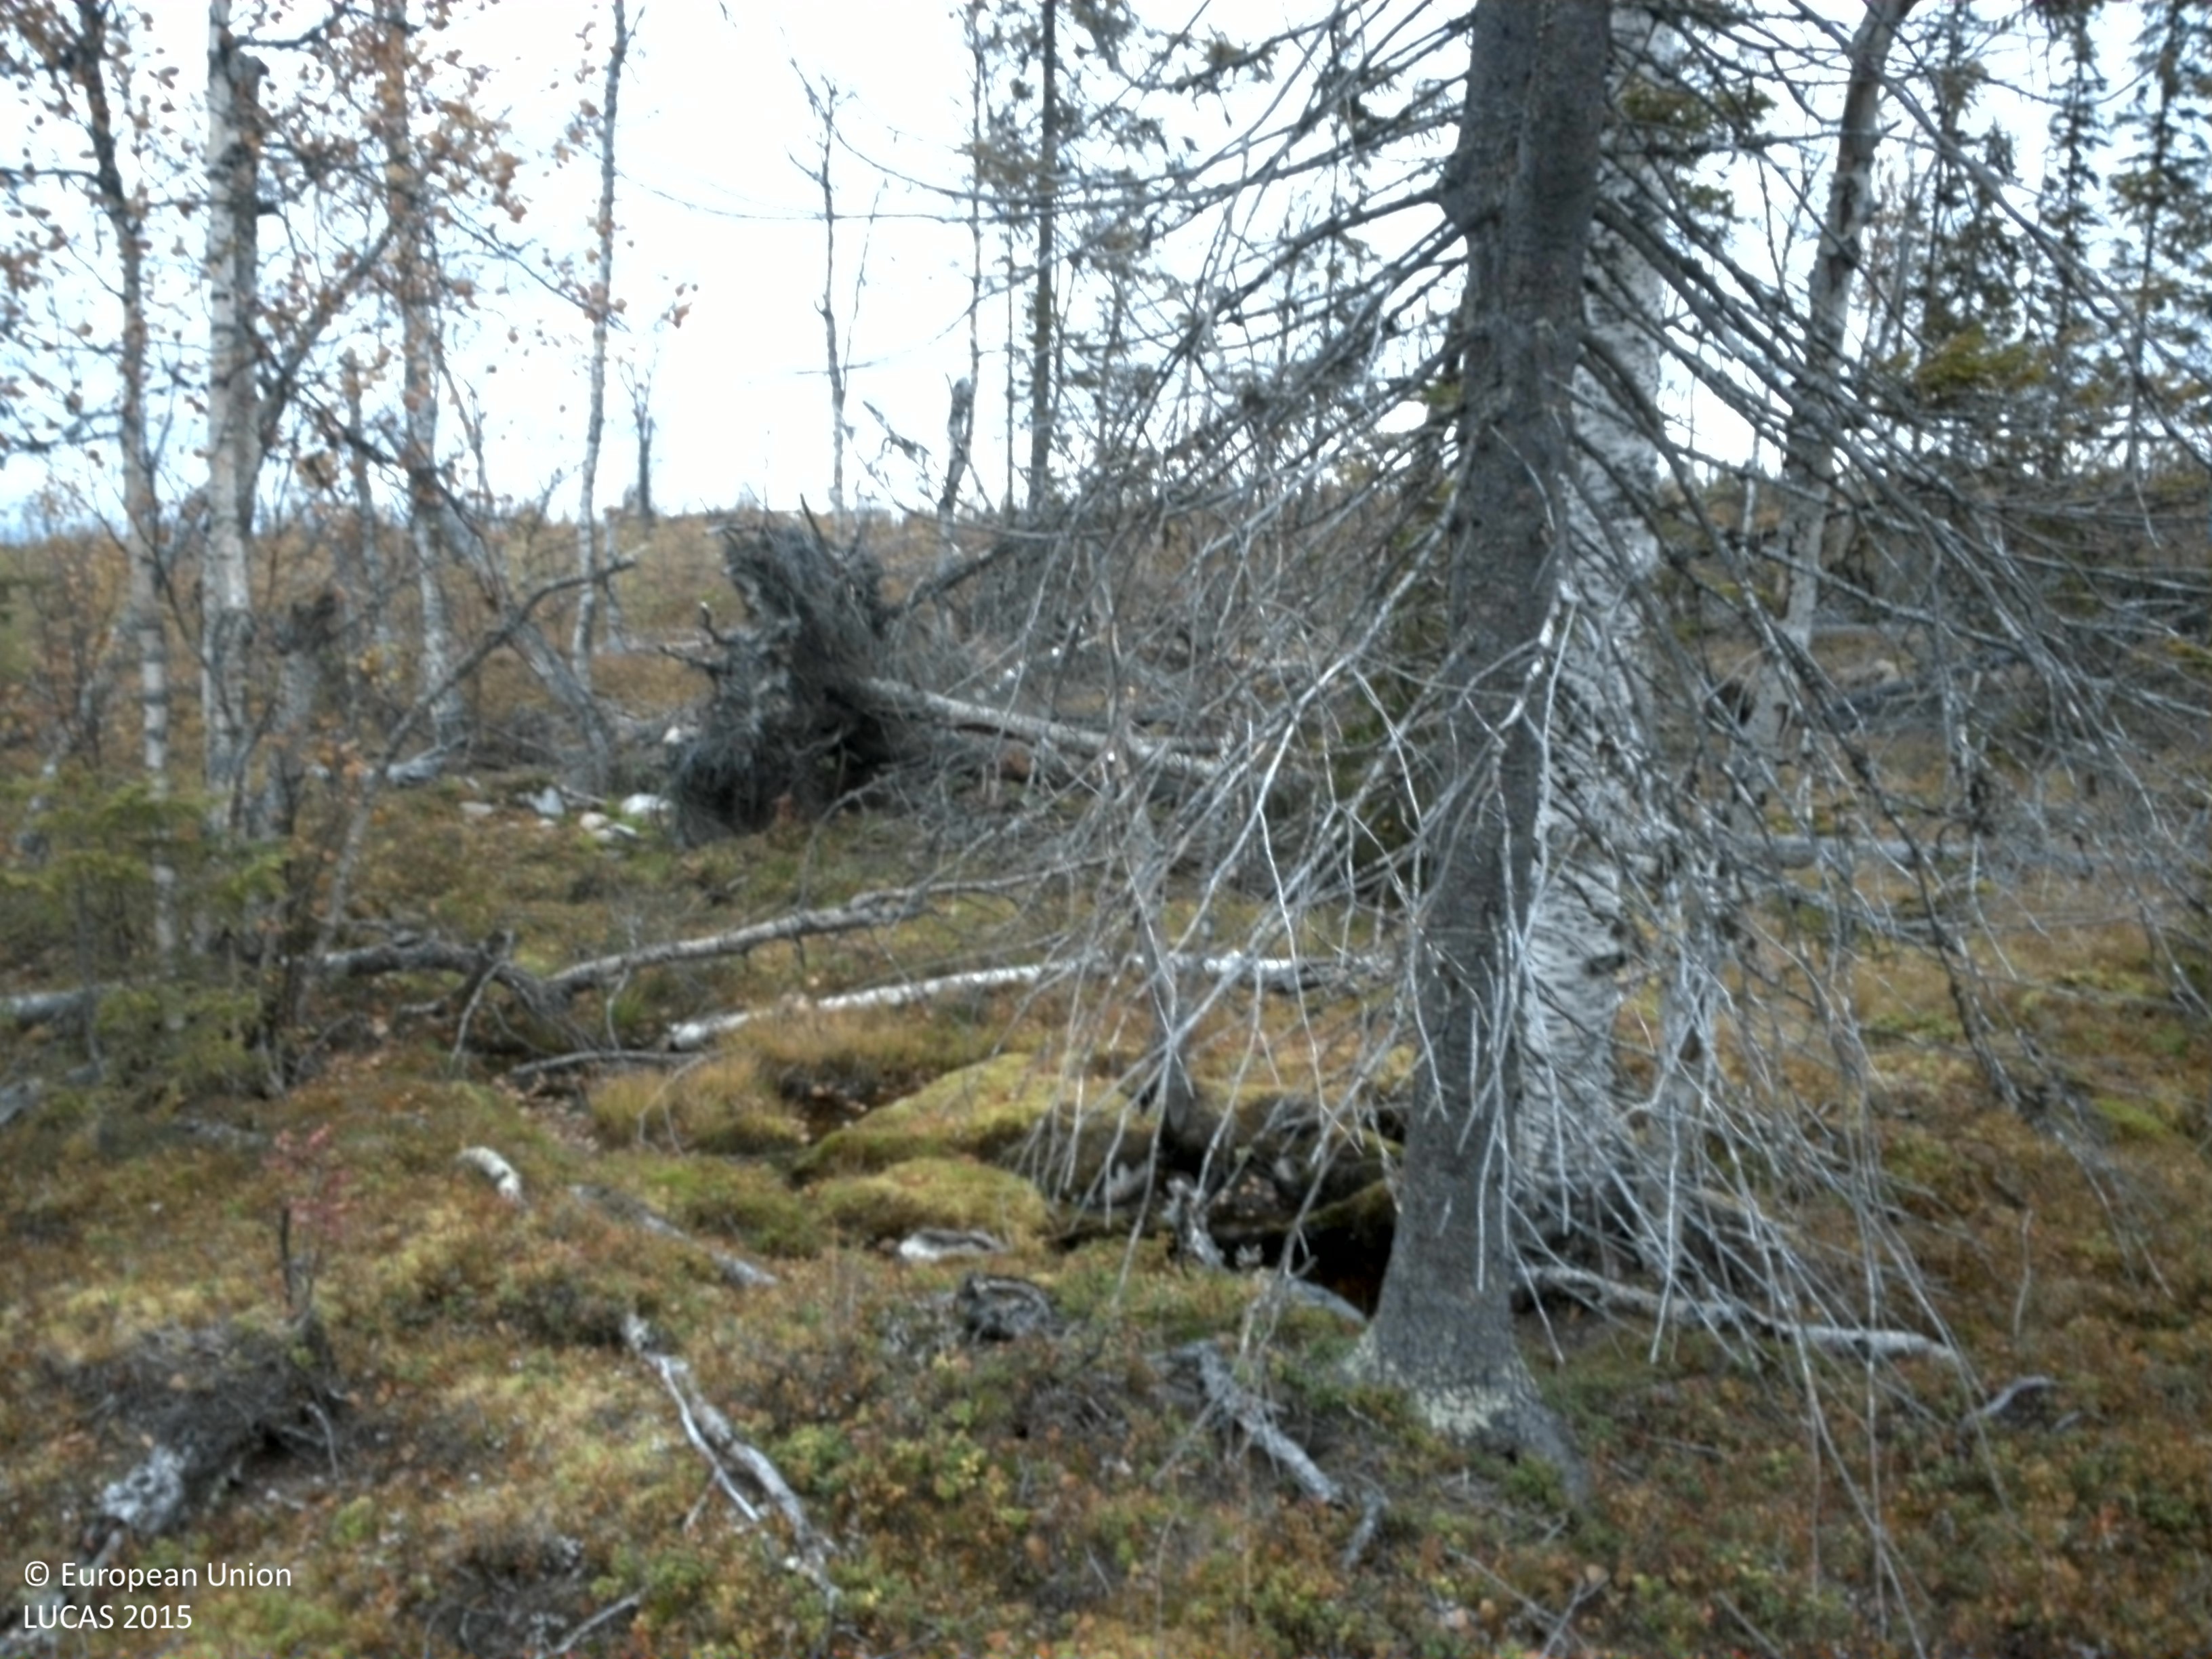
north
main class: Woodland
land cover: Other mixed woodland
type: exotic forest
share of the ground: 10 - 25 %
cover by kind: herbaceous plants 55 %, shrubs 20 %, lichens and mosses 15 %, coniferous forest trees 5 %, broadleaved forest trees 5 %
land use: Forestry
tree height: < 5 m
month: October
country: SE
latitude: 64.9560
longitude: 16.8876
